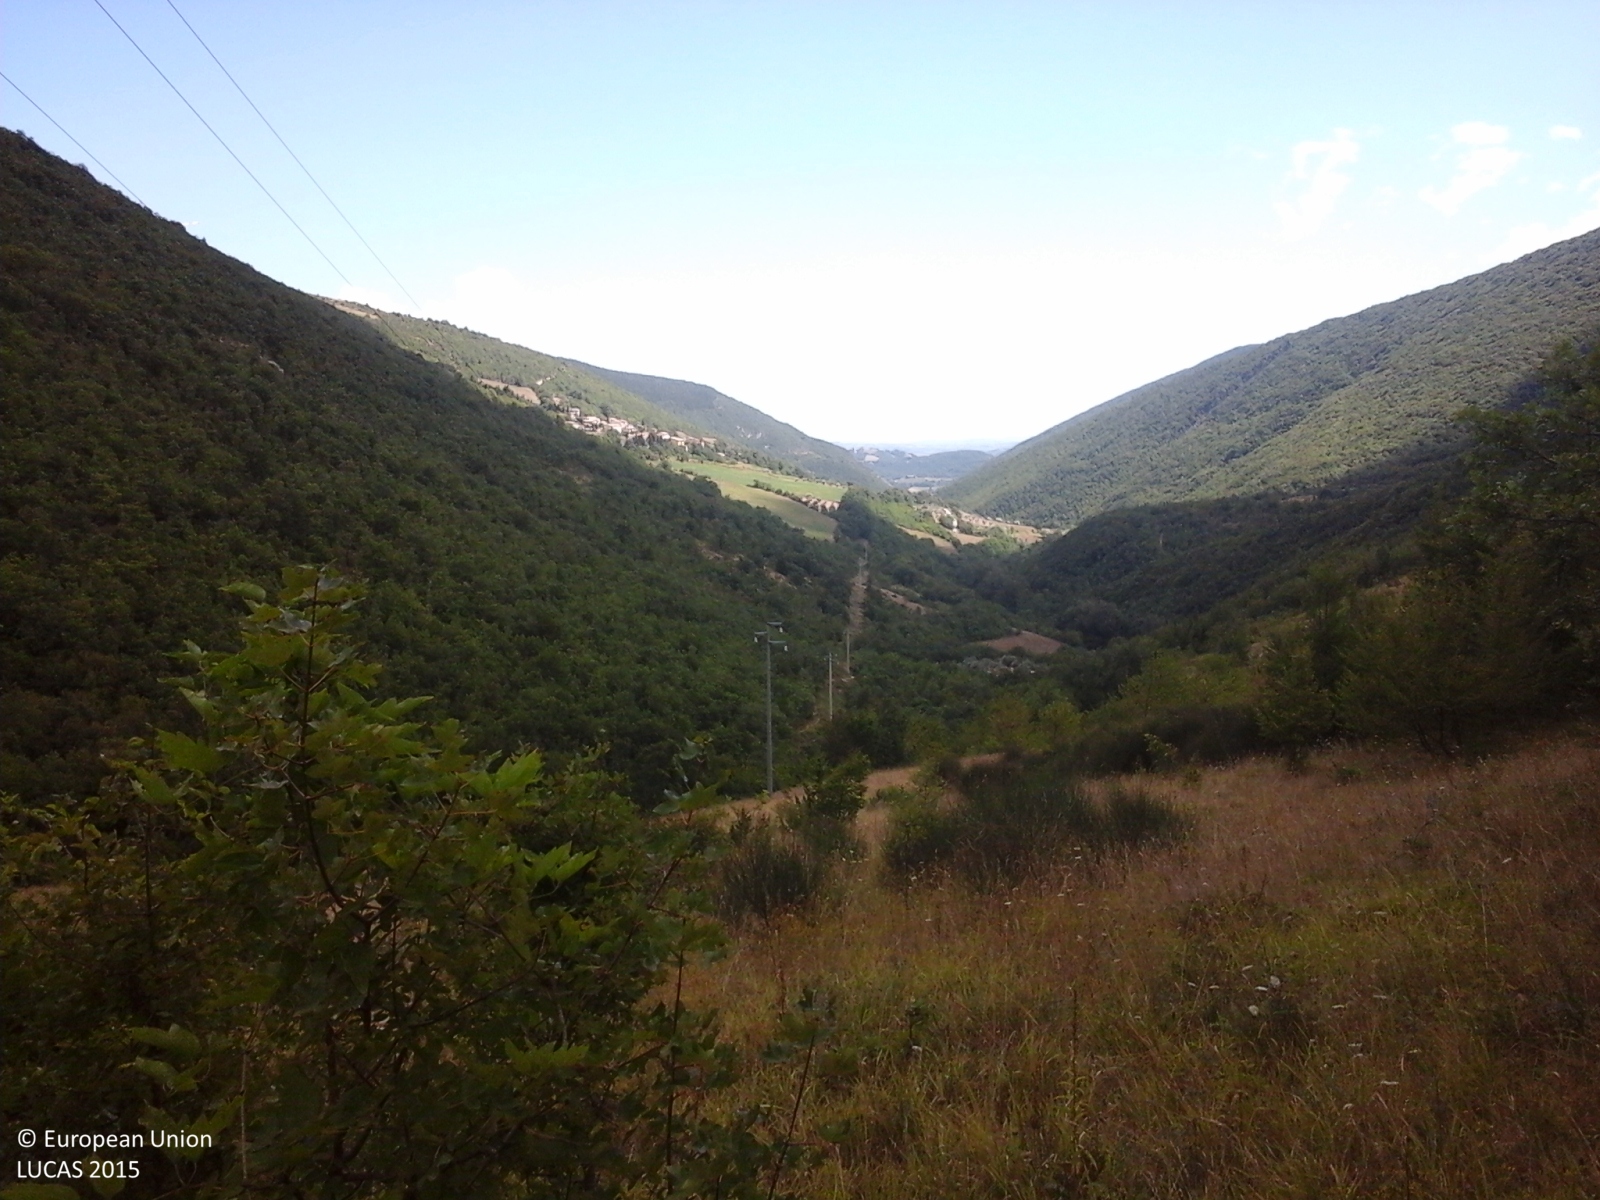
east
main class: Shrubland
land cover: Shrubland with sparse tree cover
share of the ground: > 75 %
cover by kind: herbaceous plants 55 %, shrubs 40 %, broadleaved forest trees 5 %
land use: Agriculture (excluding fallow land and kitchen gardens)
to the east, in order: Shrubland with sparse tree cover; Grassland without tree/shrub cover; Electric lines; Grassland without tree/shrub cover; Broadleaved woodland; Grassland without tree/shrub cover; Broadleaved woodland; Tracks; Broadleaved woodland
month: August
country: IT
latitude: 43.1839
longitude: 13.1289
